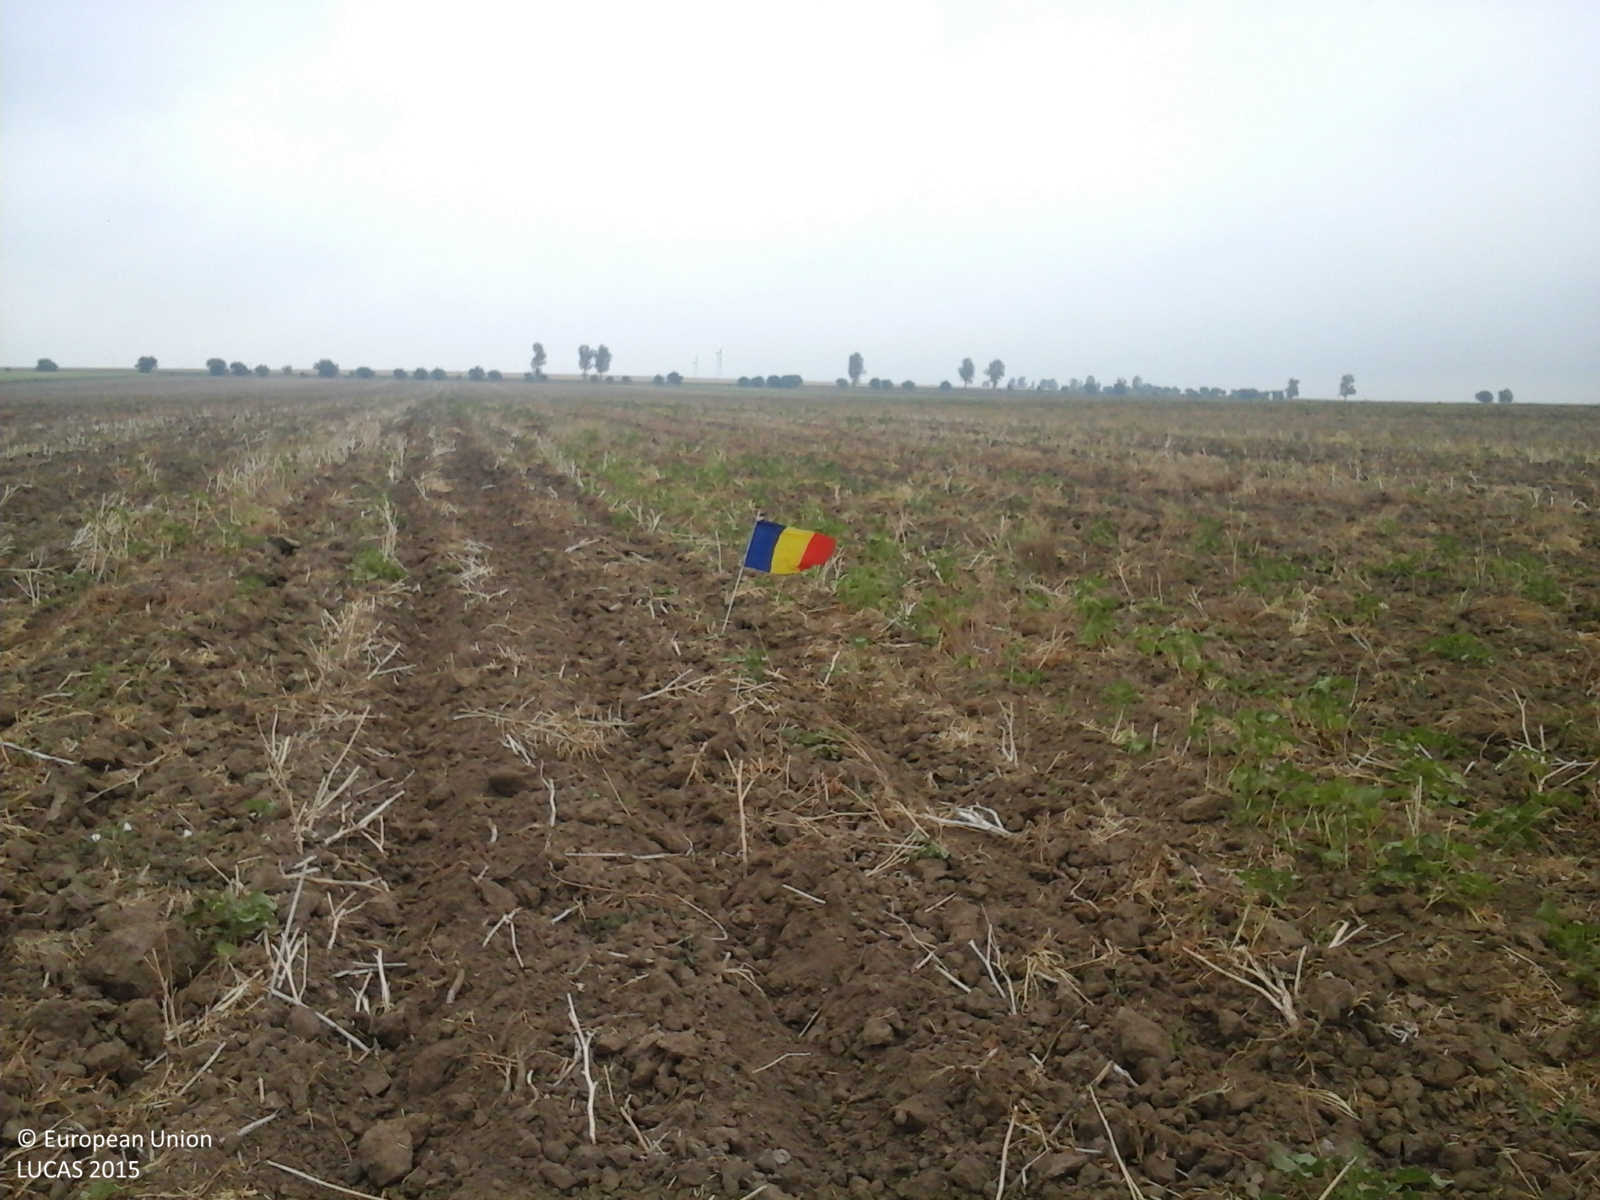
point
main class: Cropland
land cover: Rape and turnip rape
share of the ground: 10 - 25 %
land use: Agriculture (excluding fallow land and kitchen gardens)
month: August
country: RO
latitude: 44.8467
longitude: 28.3020
